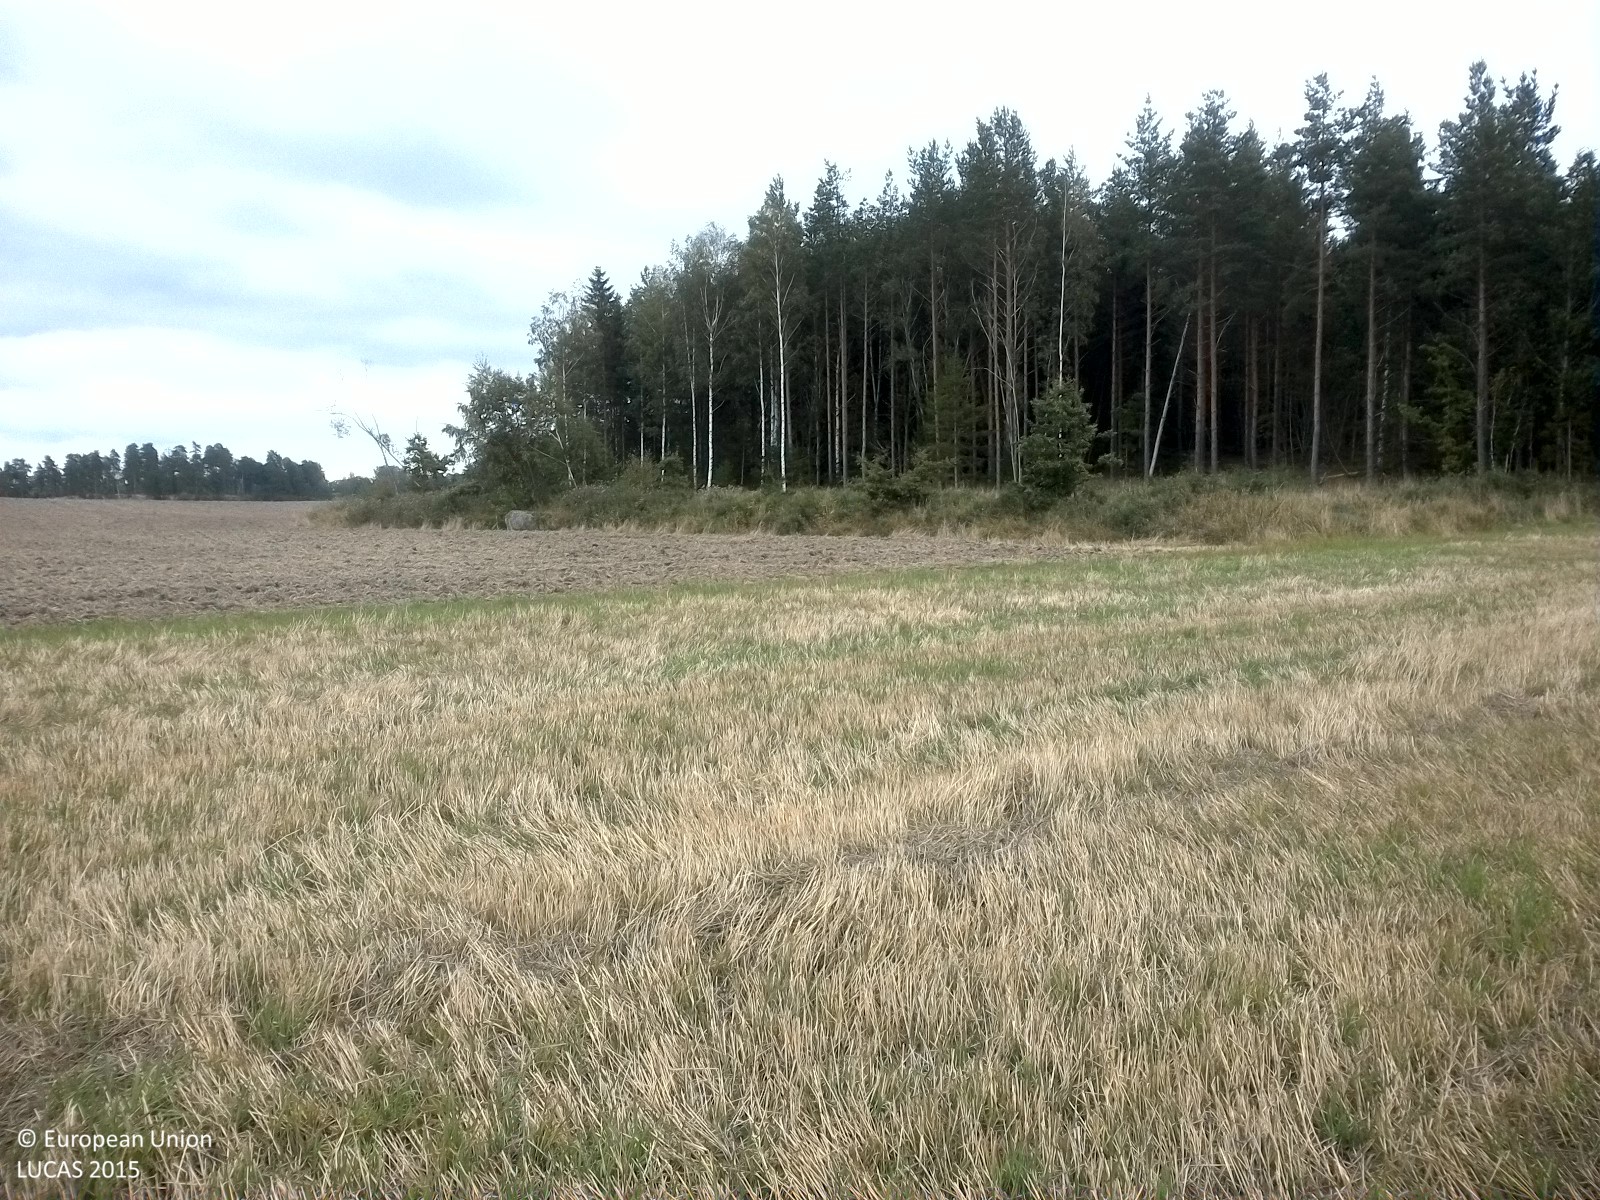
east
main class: Cropland
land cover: Temporary grasslands
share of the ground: > 75 %
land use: Agriculture (excluding fallow land and kitchen gardens)
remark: Harvested field
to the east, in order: Temporary grasslands; Common wheat; Ditches and canals; Shrubland without tree cover; Pine dominated mixed woodland; Pine dominated coniferous woodland; Shrubland without tree cover; Common wheat
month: September
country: SE
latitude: 58.5884
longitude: 16.4466
